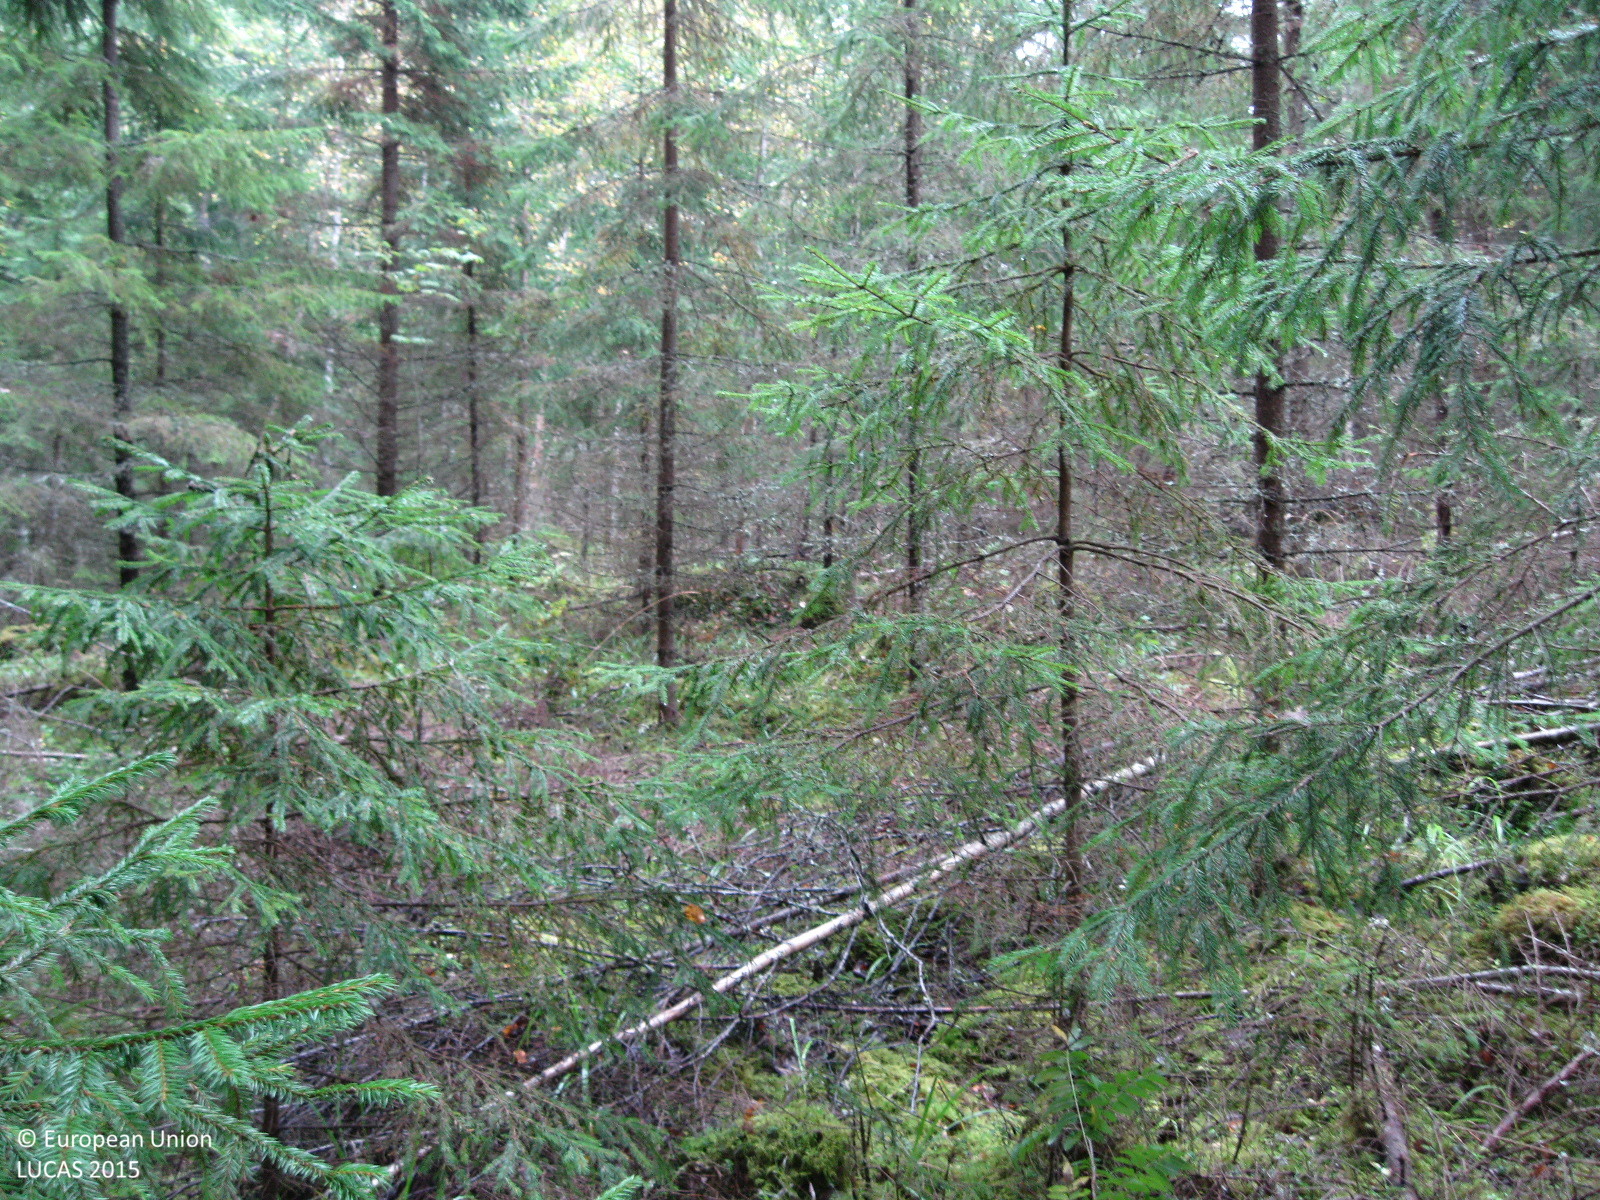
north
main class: Woodland
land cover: Spruce dominated mixed woodland
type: boreal forest
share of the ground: > 75 %
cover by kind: coniferous forest trees 60 %, broadleaved forest trees 20 %, lichens and mosses 10 %, shrubs 5 %, herbaceous plants 5 %
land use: Forestry
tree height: > 5 m
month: September
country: FI
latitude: 60.9399
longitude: 25.1215
